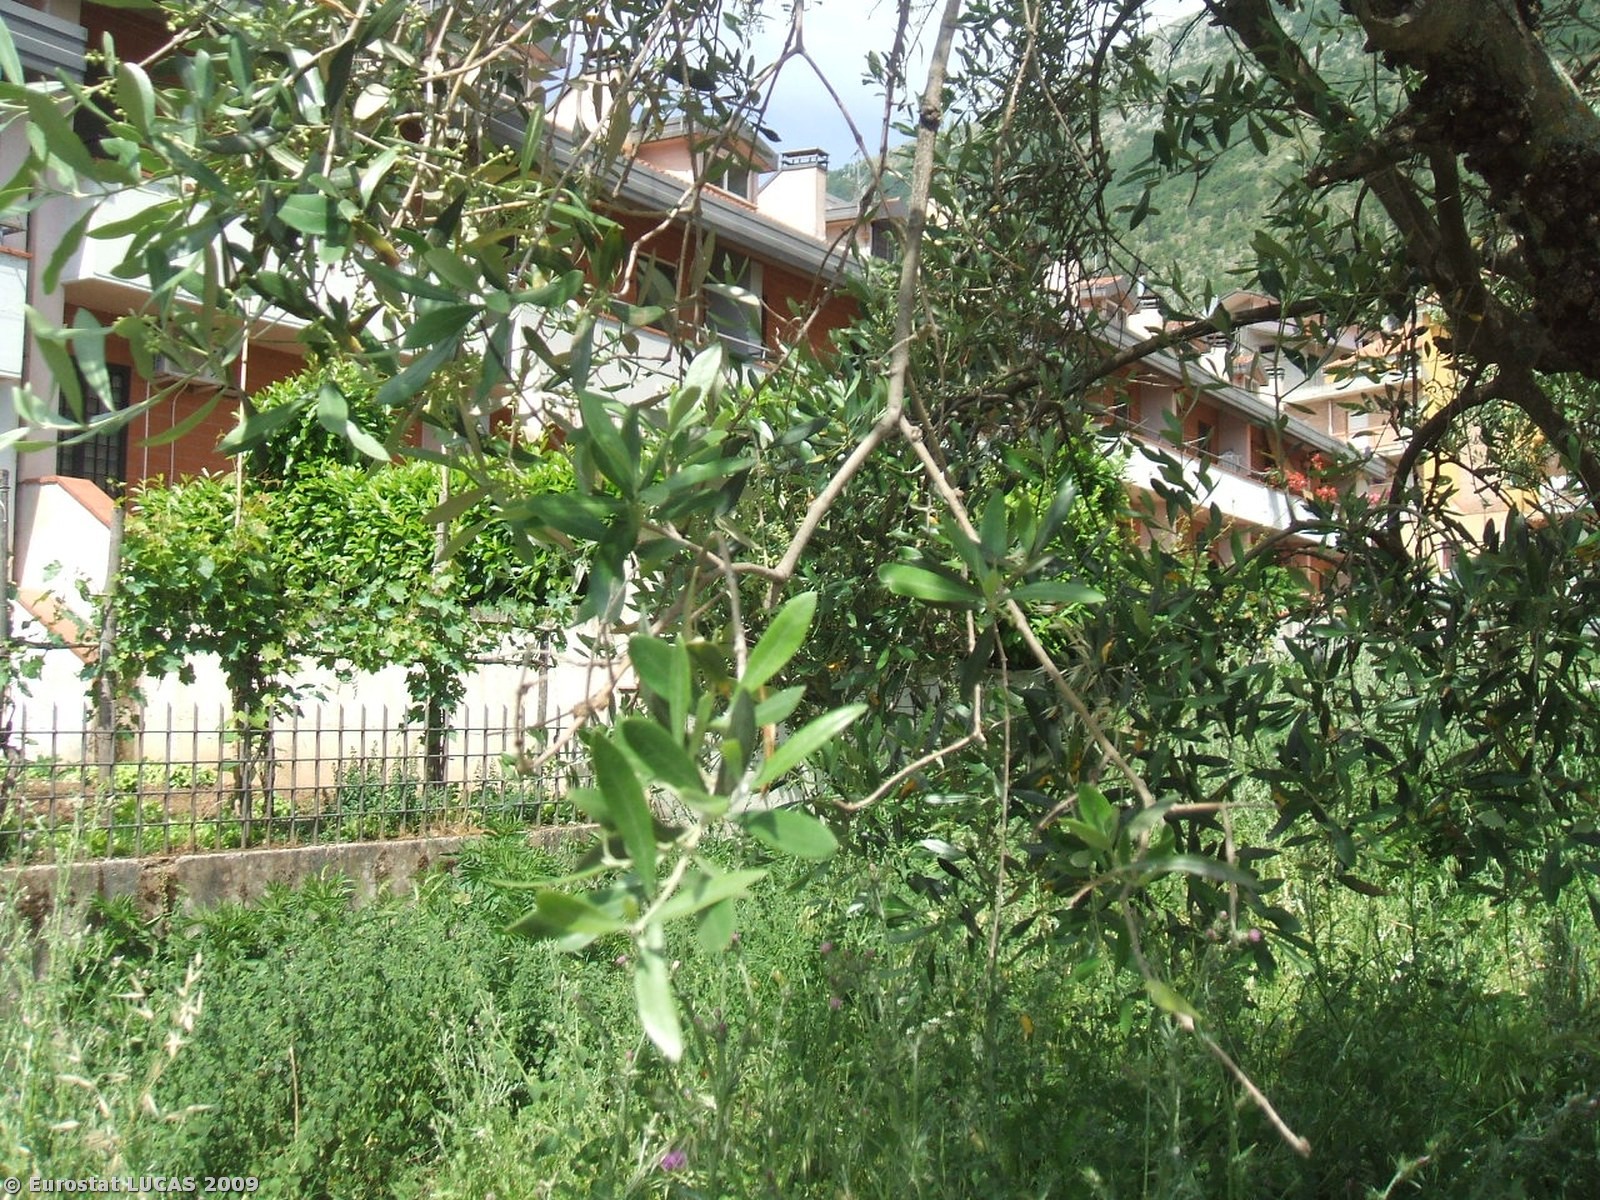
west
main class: Cropland
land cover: Olive groves
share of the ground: 25 - 50 %
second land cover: Spontaneously vegetated surfaces
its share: > 75 %
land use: Agriculture (excluding fallow land and kitchen gardens)
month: May
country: IT
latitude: 40.3462
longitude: 15.5453
